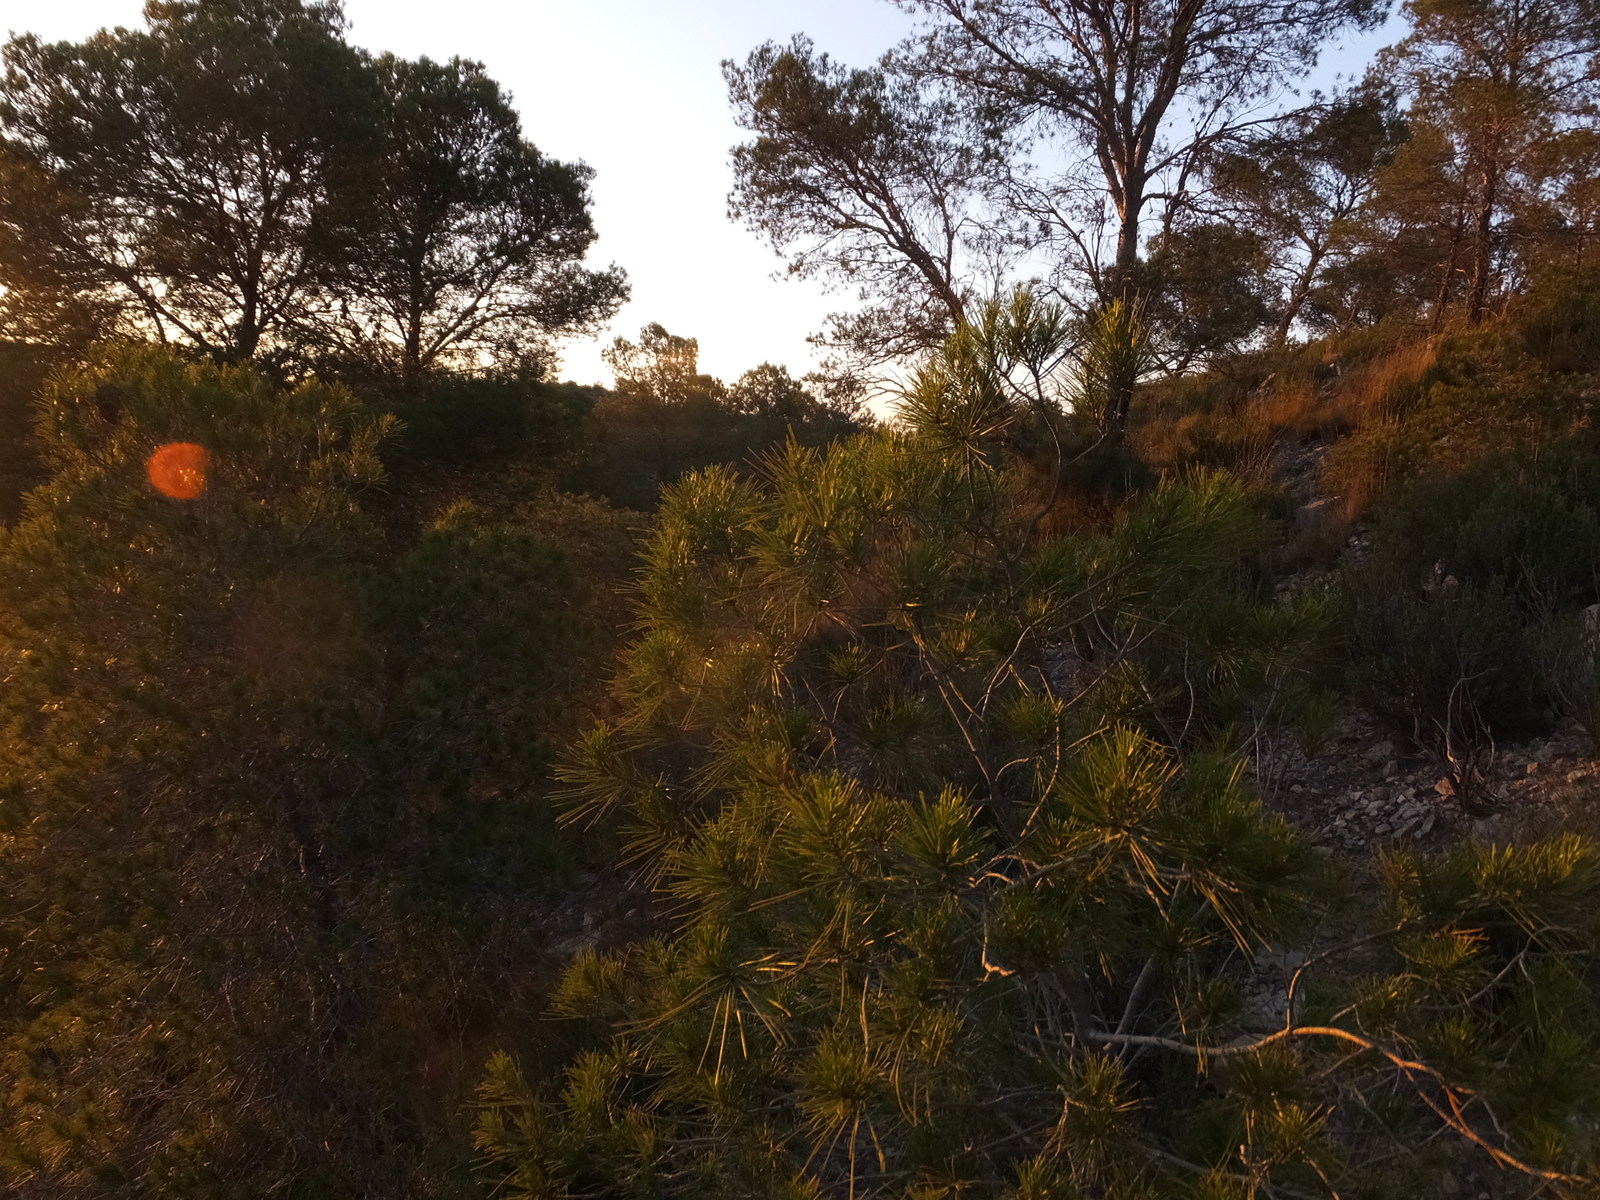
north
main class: Woodland
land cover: Pine dominated mixed woodland
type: coniferous forest of the mediterranean region
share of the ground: 25 - 50 %
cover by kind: shrubs 50 %, coniferous forest trees 25 %, broadleaved forest trees 15 %, herbaceous plants 10 %
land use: Forestry
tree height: < 5 m
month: June
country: ES
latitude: 41.3494
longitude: -0.2575
